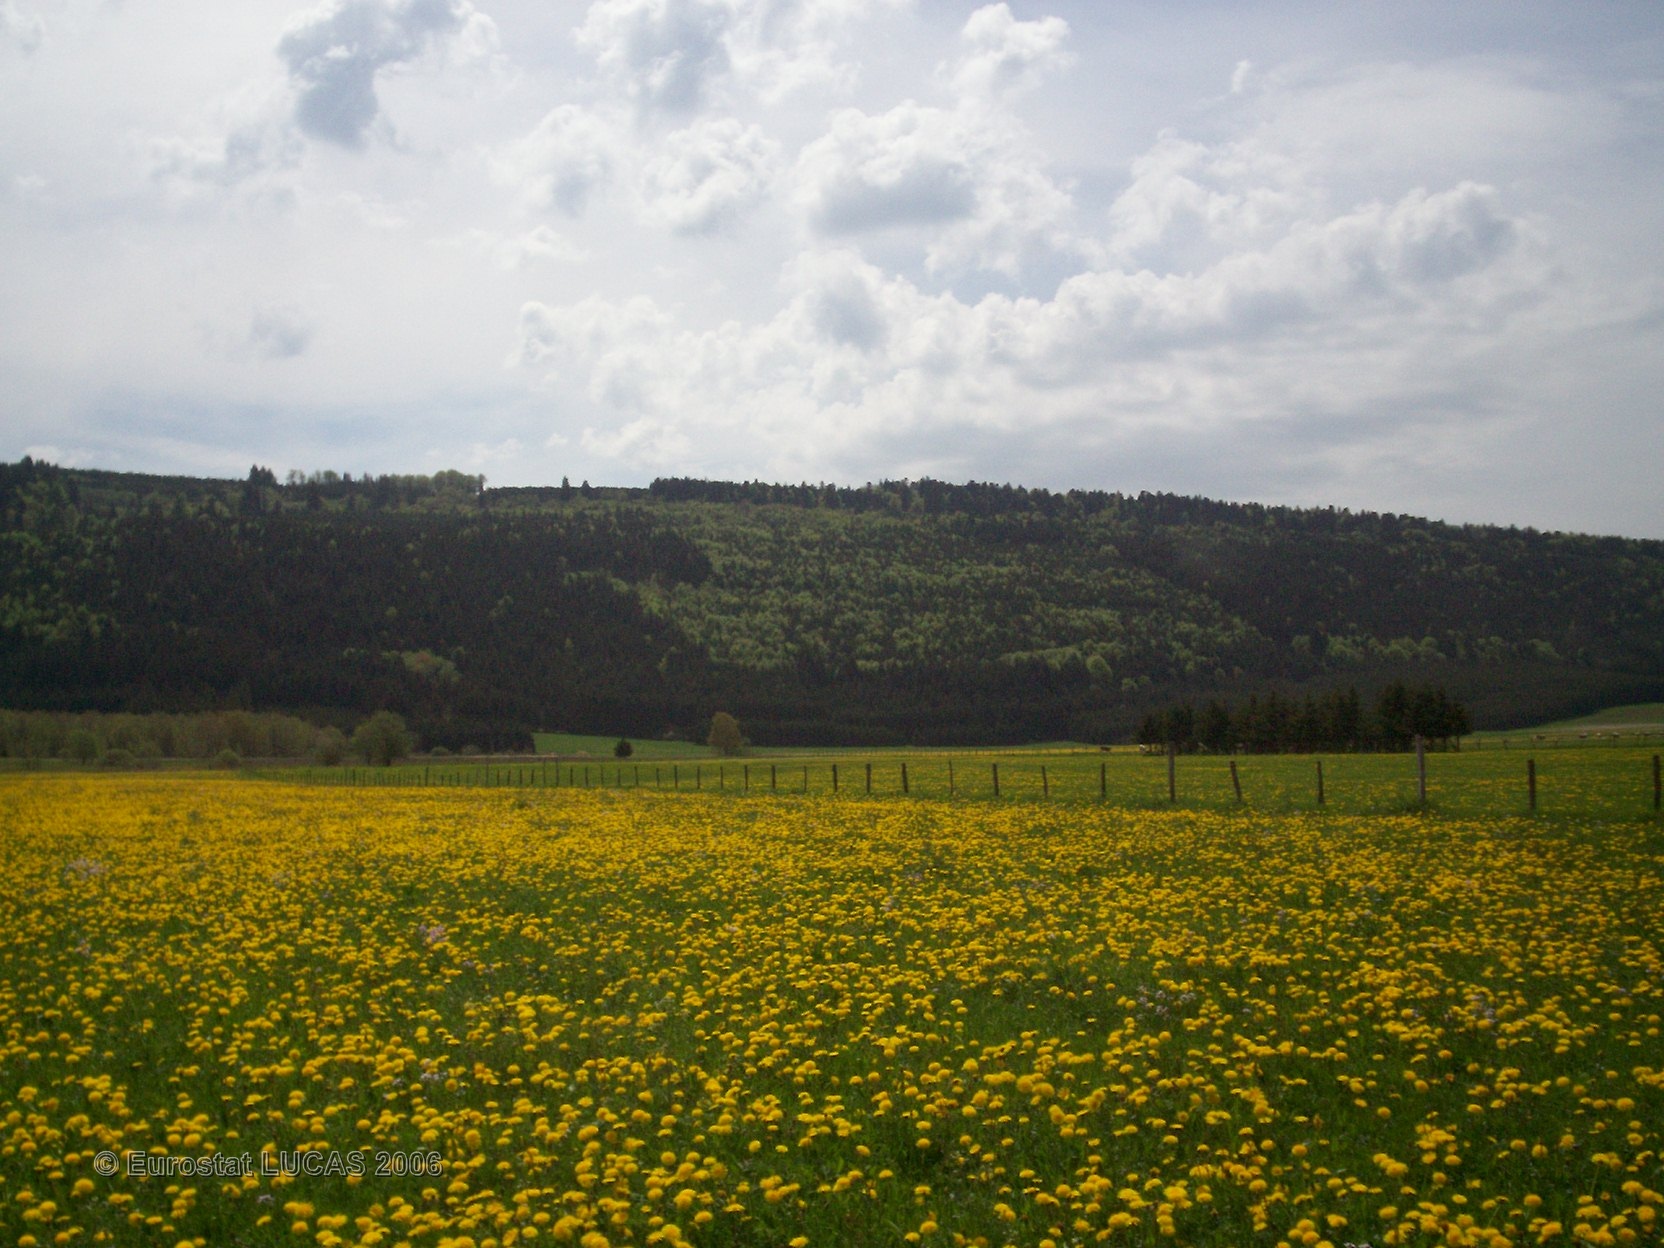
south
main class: Grassland
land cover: Grassland without tree/shrub cover
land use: Agriculture (excluding fallow land and kitchen gardens)
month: May
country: FR
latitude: 47.0471
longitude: 6.3825
